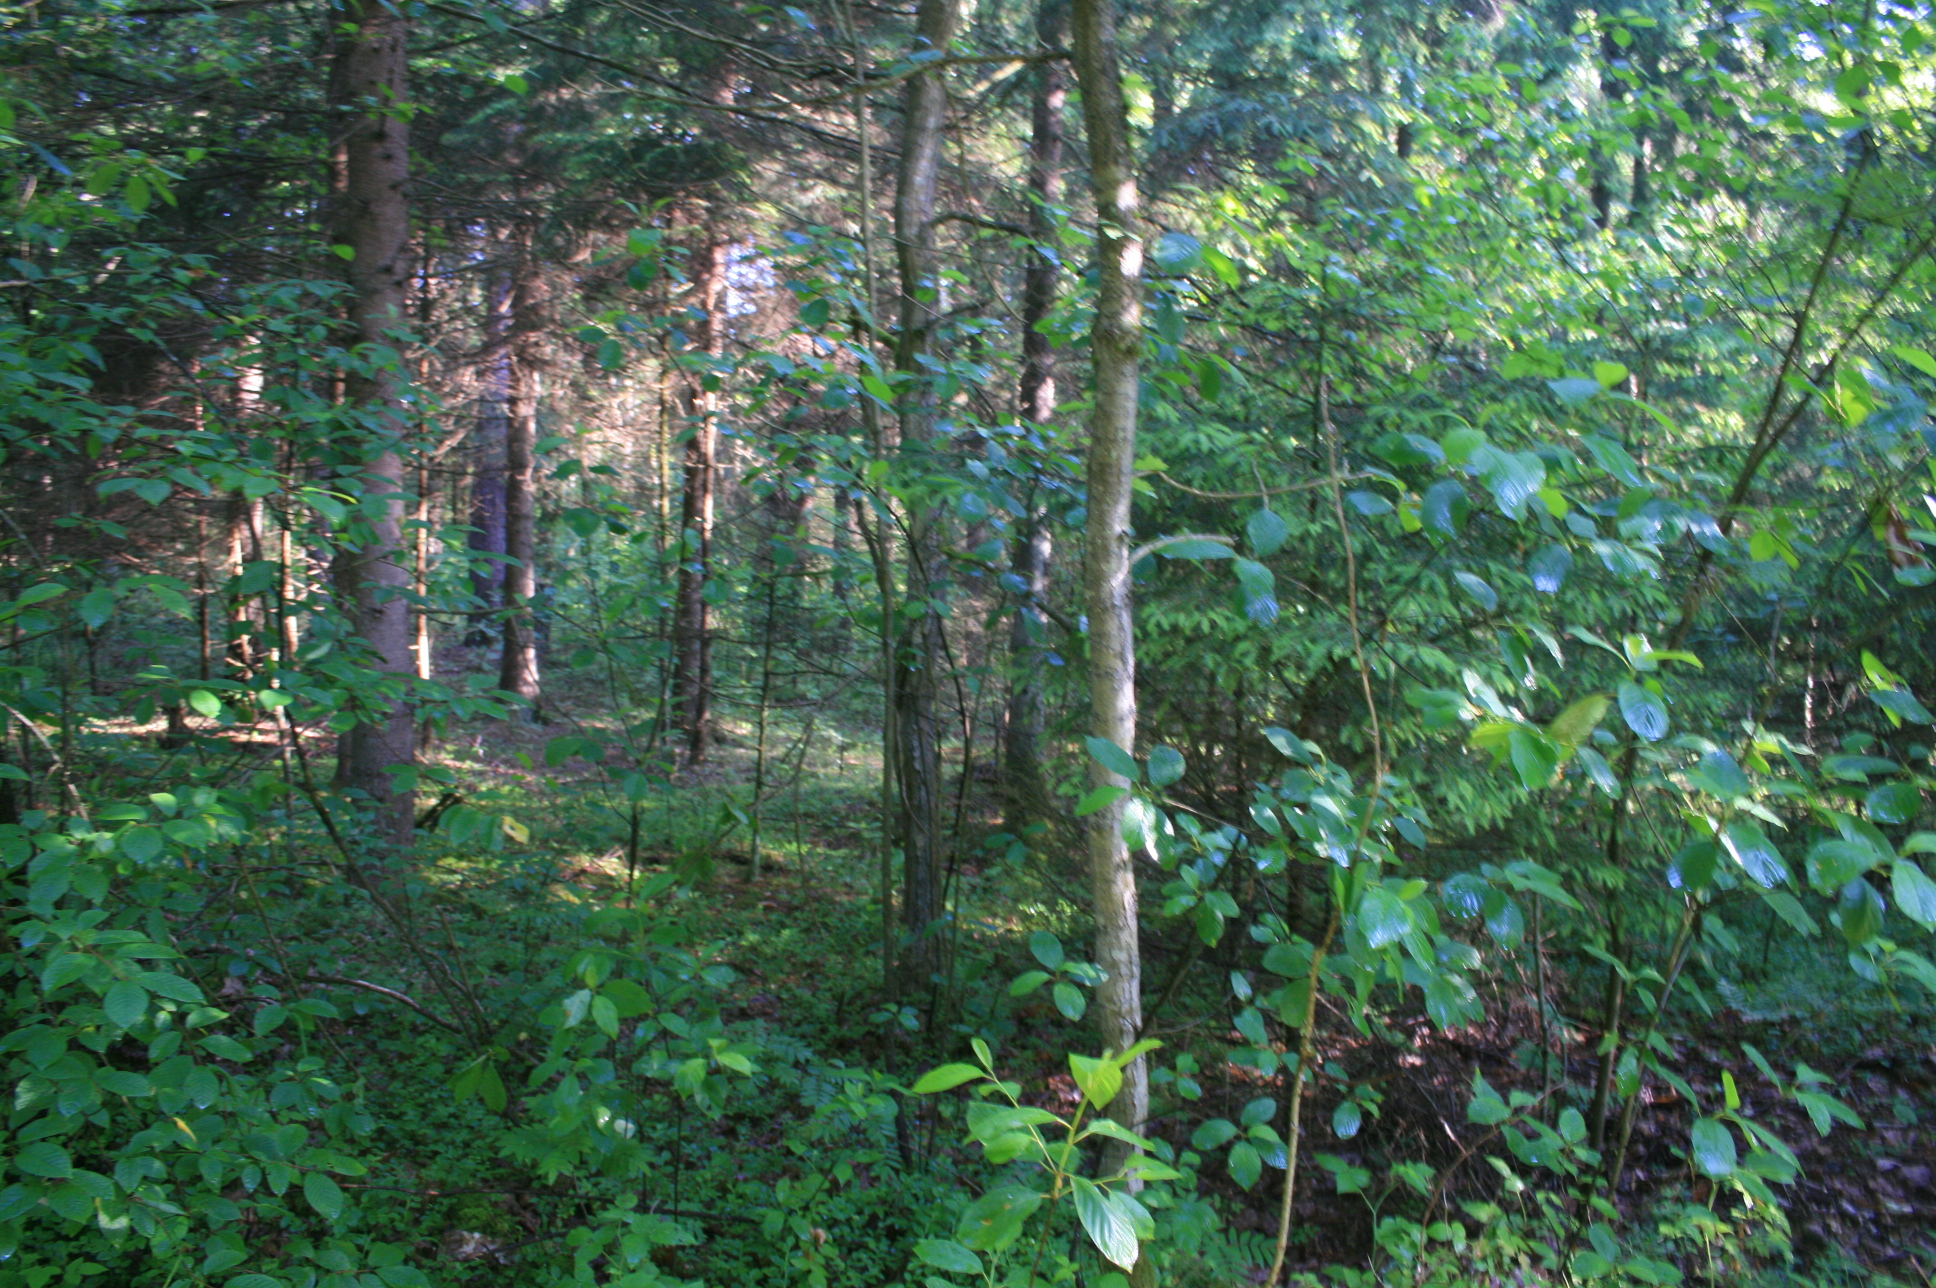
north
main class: Woodland
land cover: Spruce dominated mixed woodland
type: hemiboreal forest and nemoral coniferous forest and mixed broadleaved-coniferous forest
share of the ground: > 75 %
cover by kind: coniferous forest trees 60 %, broadleaved forest trees 25 %, herbaceous plants 15 %
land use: Forestry
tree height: > 5 m
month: June
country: LT
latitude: 55.2345
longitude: 22.2445
